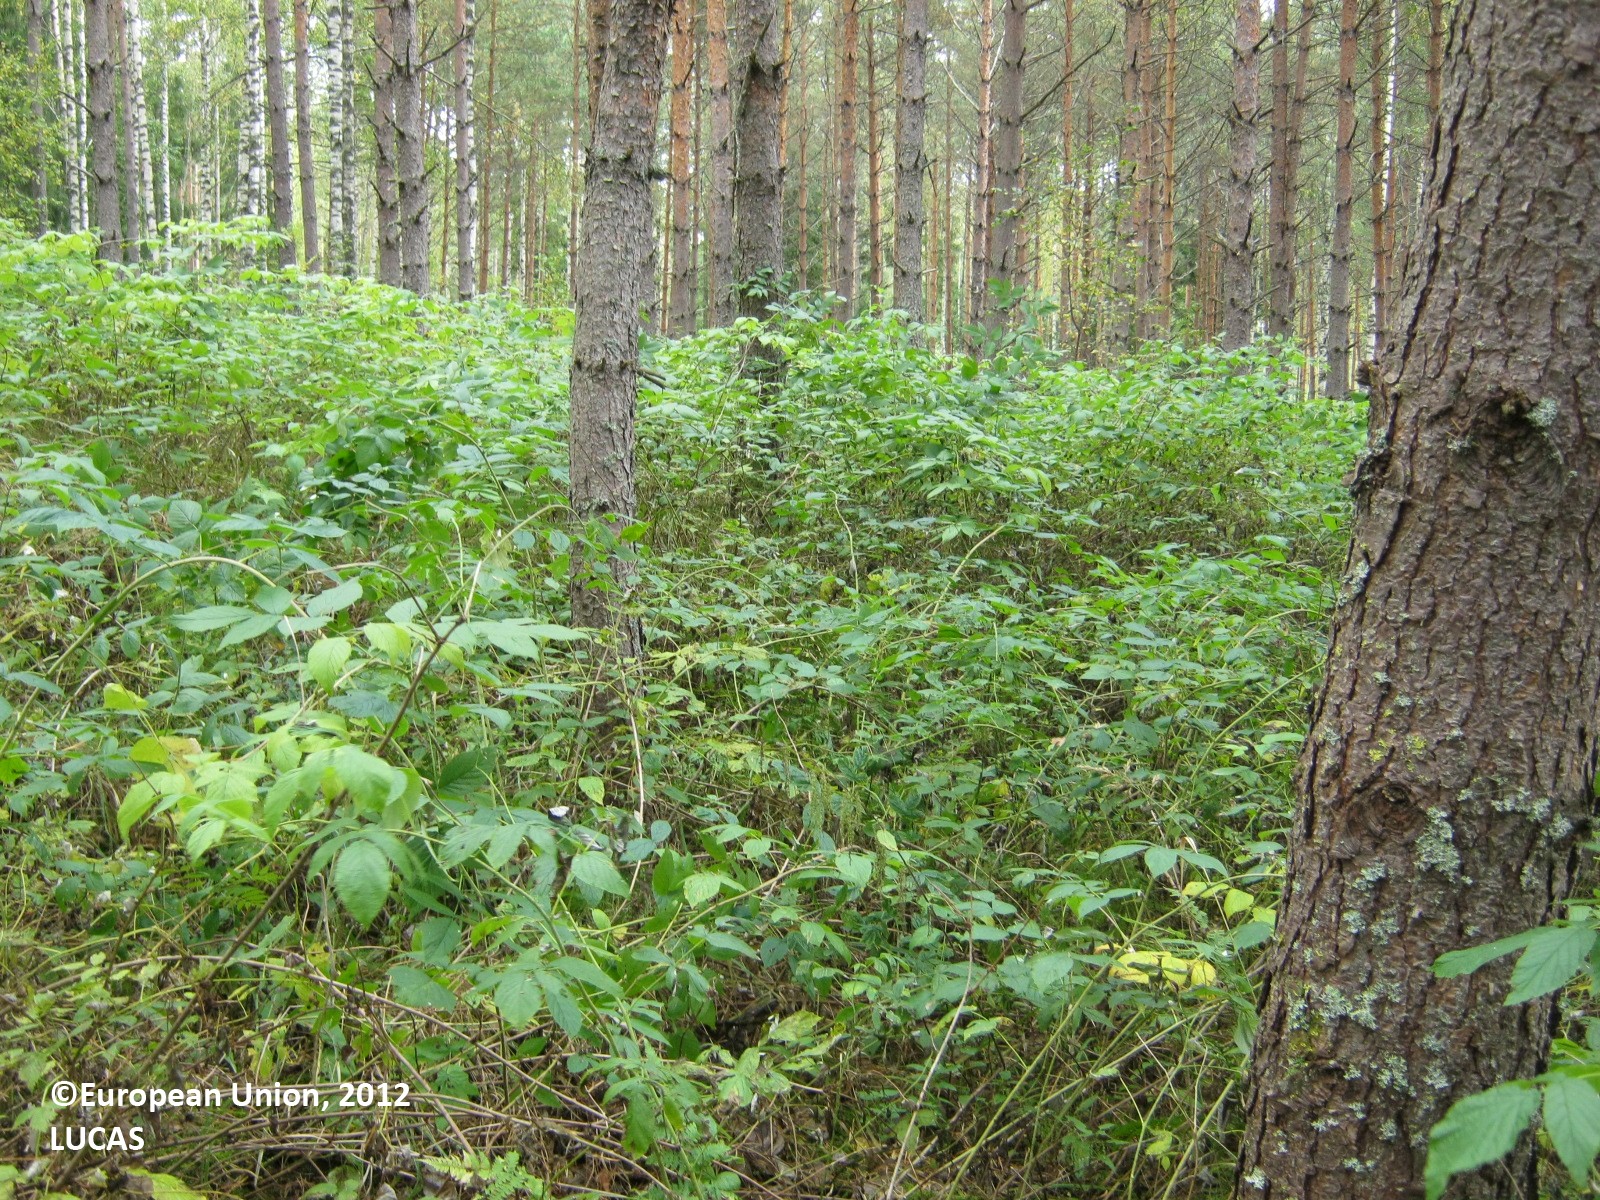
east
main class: Woodland
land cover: Spruce dominated mixed woodland
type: boreal forest
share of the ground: > 75 %
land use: Forestry
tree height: > 5 m
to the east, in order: Spruce dominated mixed woodland; Broadleaved woodland; Ditches and canals; Spruce dominated mixed woodland; Tracks; Ditches and canals; Spruce dominated mixed woodland
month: September
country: FI
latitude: 60.6845
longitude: 27.7902
